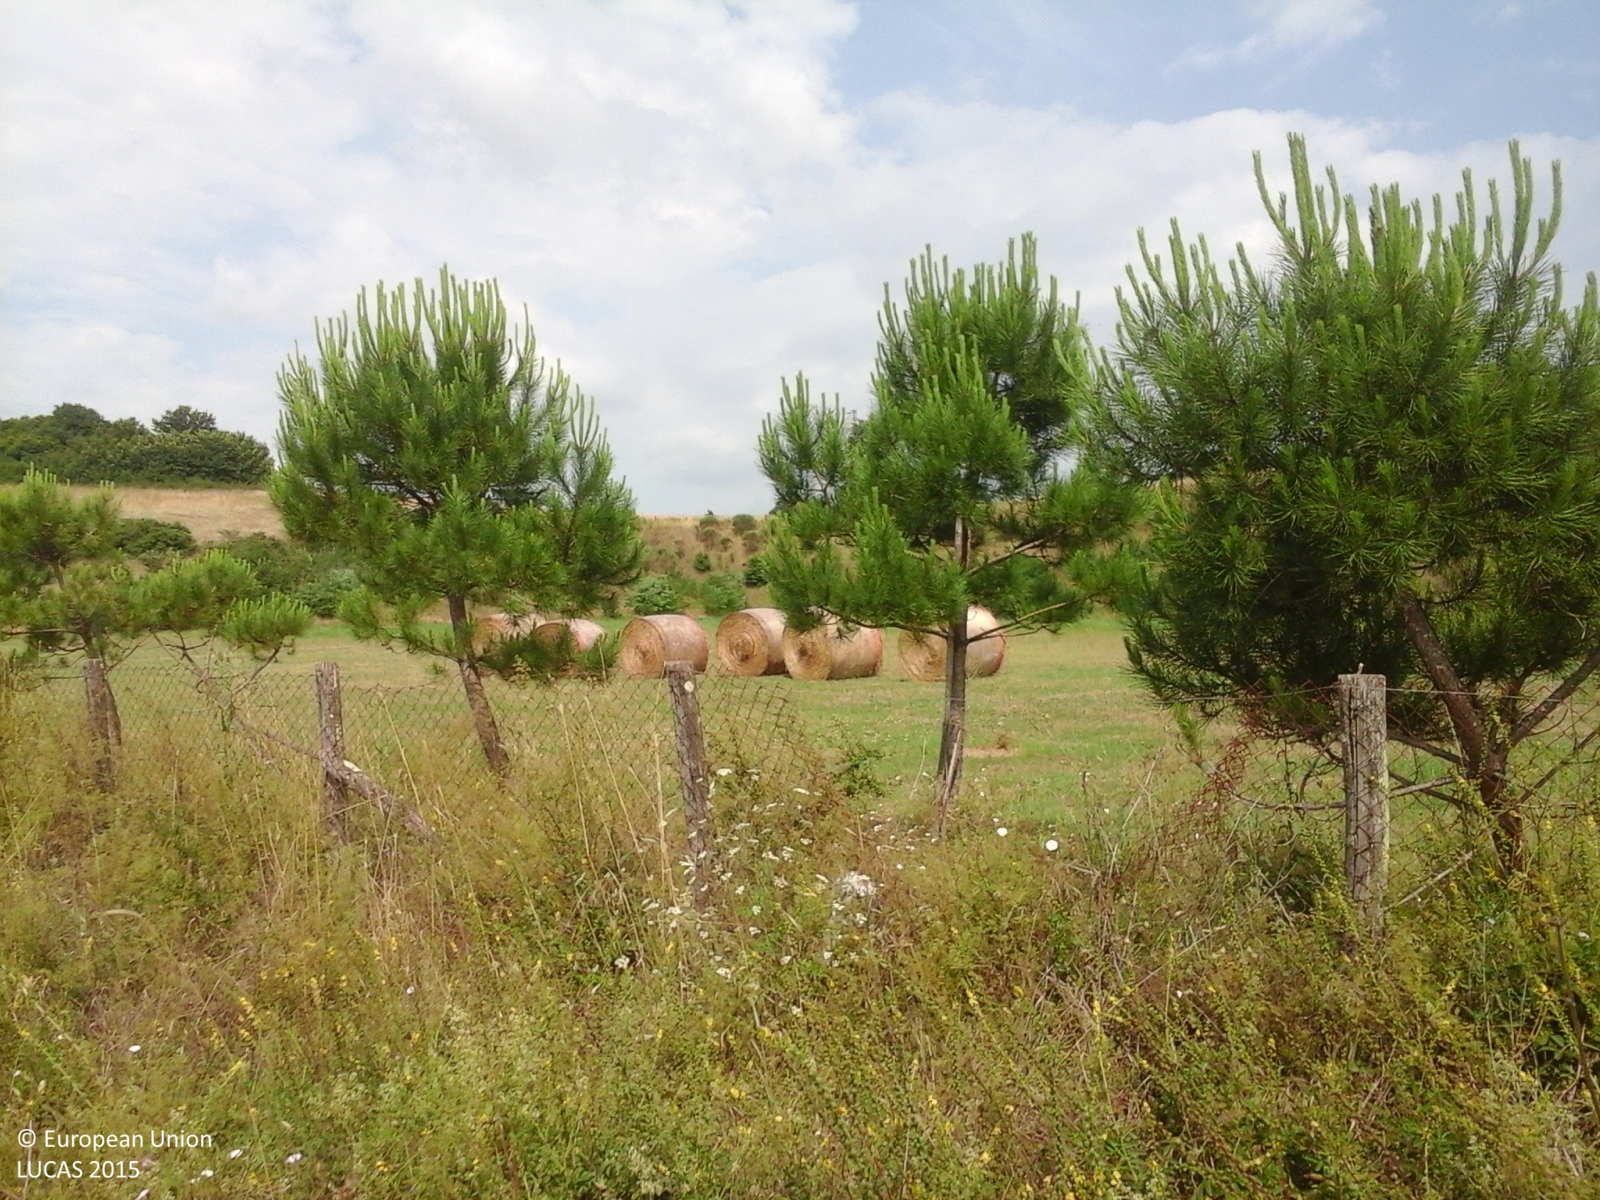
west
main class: Cropland
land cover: Temporary grasslands
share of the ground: > 75 %
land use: Agriculture (excluding fallow land and kitchen gardens)
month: June
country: IT
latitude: 41.7604
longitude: 12.9837
